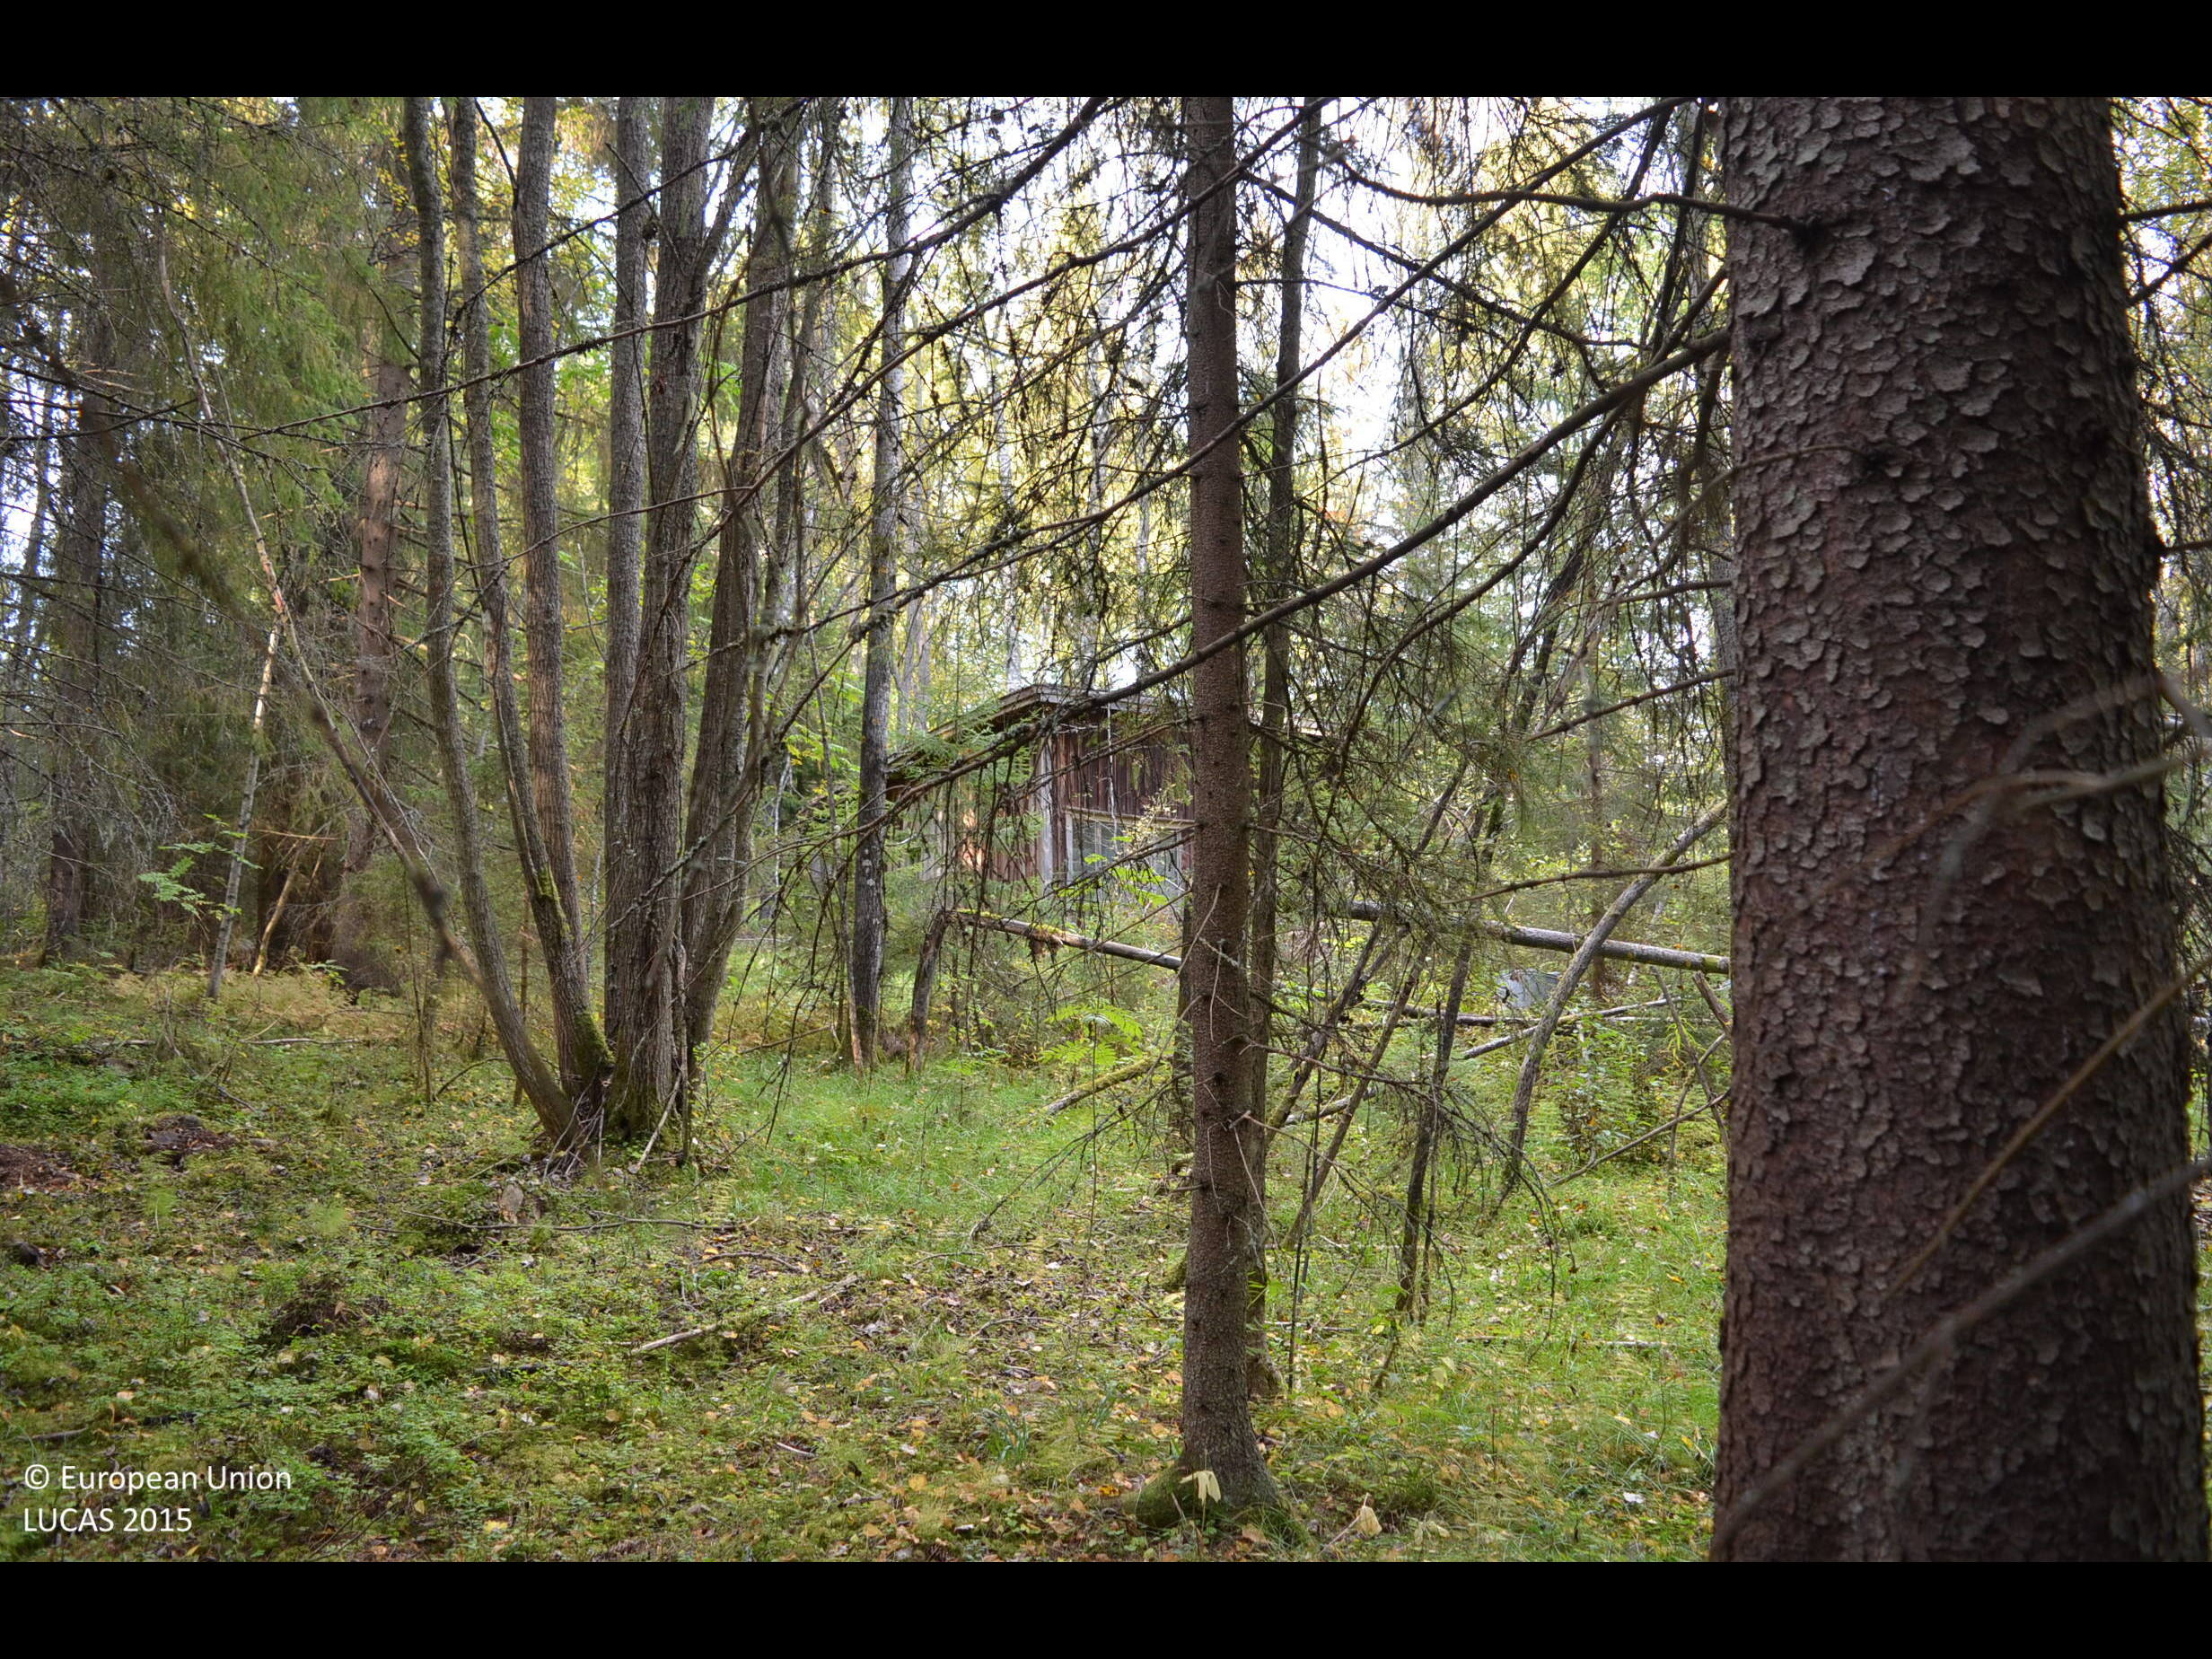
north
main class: Woodland
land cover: Other mixed woodland
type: boreal forest
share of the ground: > 75 %
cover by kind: coniferous forest trees 50 %, broadleaved forest trees 30 %, herbaceous plants 15 %, shrubs 5 %
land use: Forestry
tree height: > 5 m
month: September
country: FI
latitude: 63.0510
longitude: 23.8577
